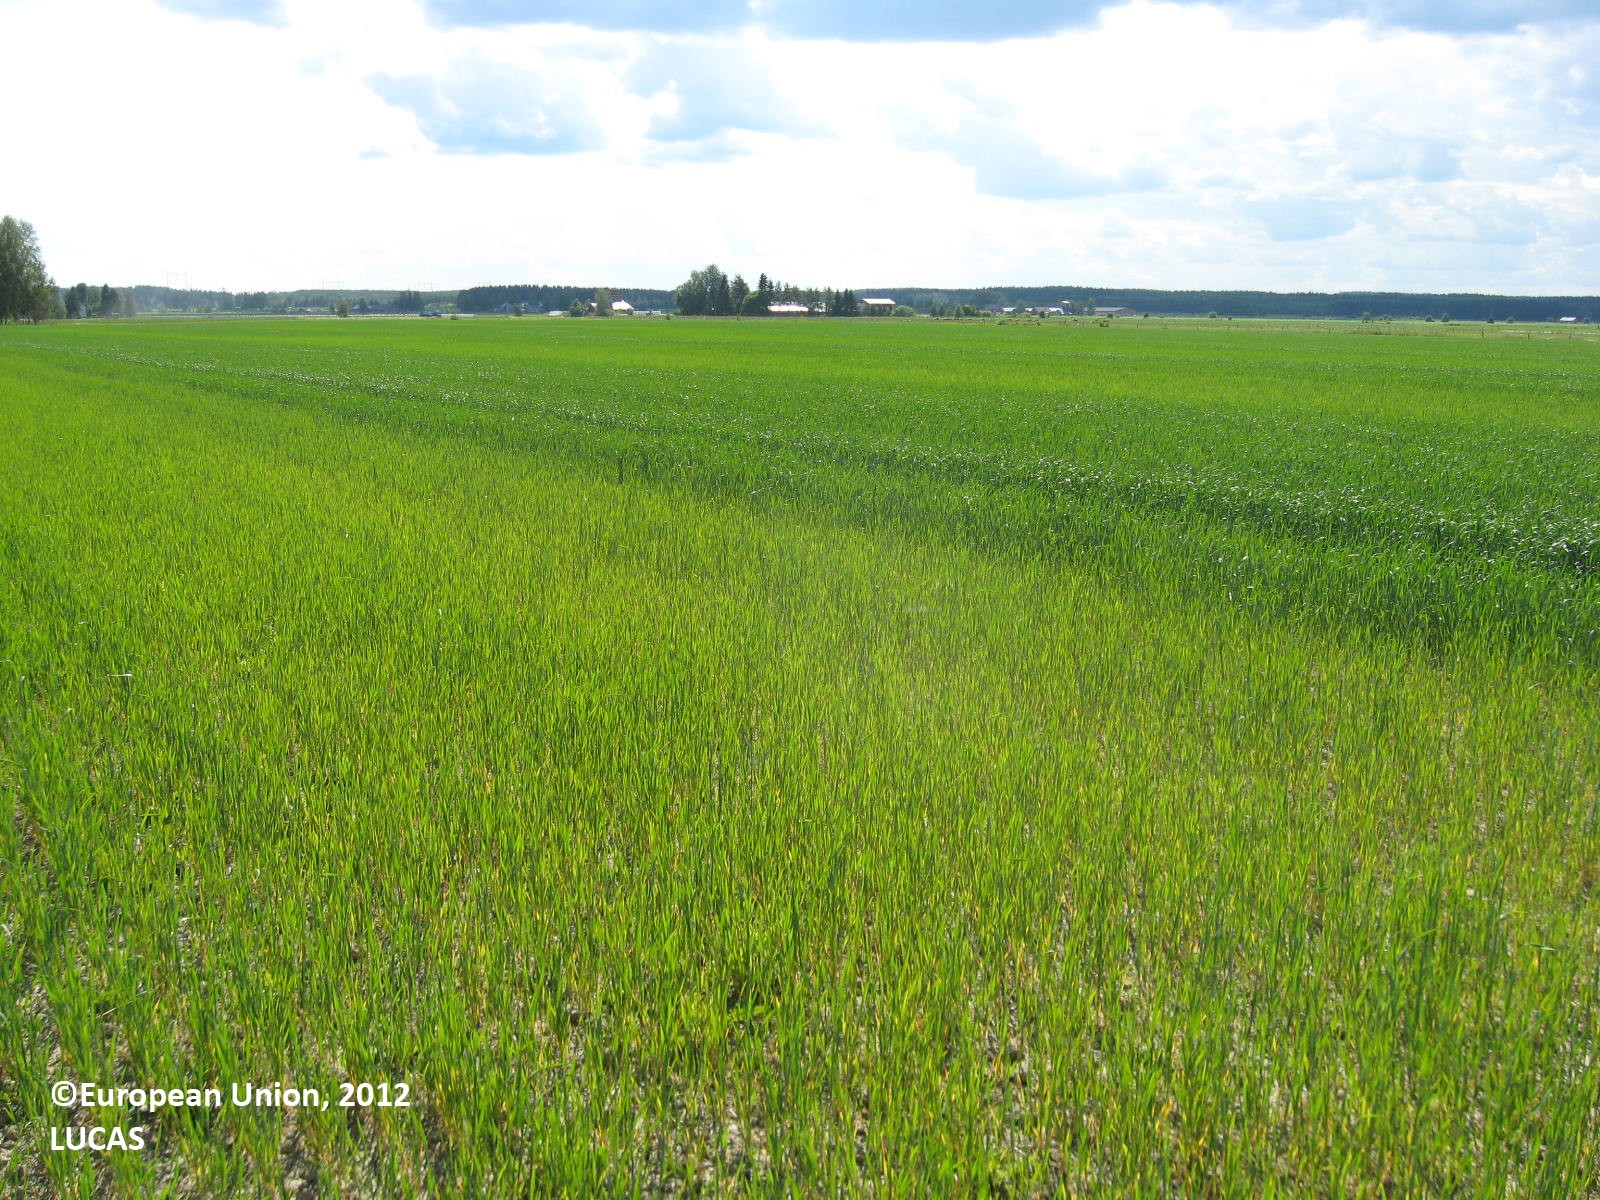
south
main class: Cropland
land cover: Common wheat
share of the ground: > 75 %
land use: Agriculture (excluding fallow land and kitchen gardens)
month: July
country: FI
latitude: 62.5804
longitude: 22.5326
